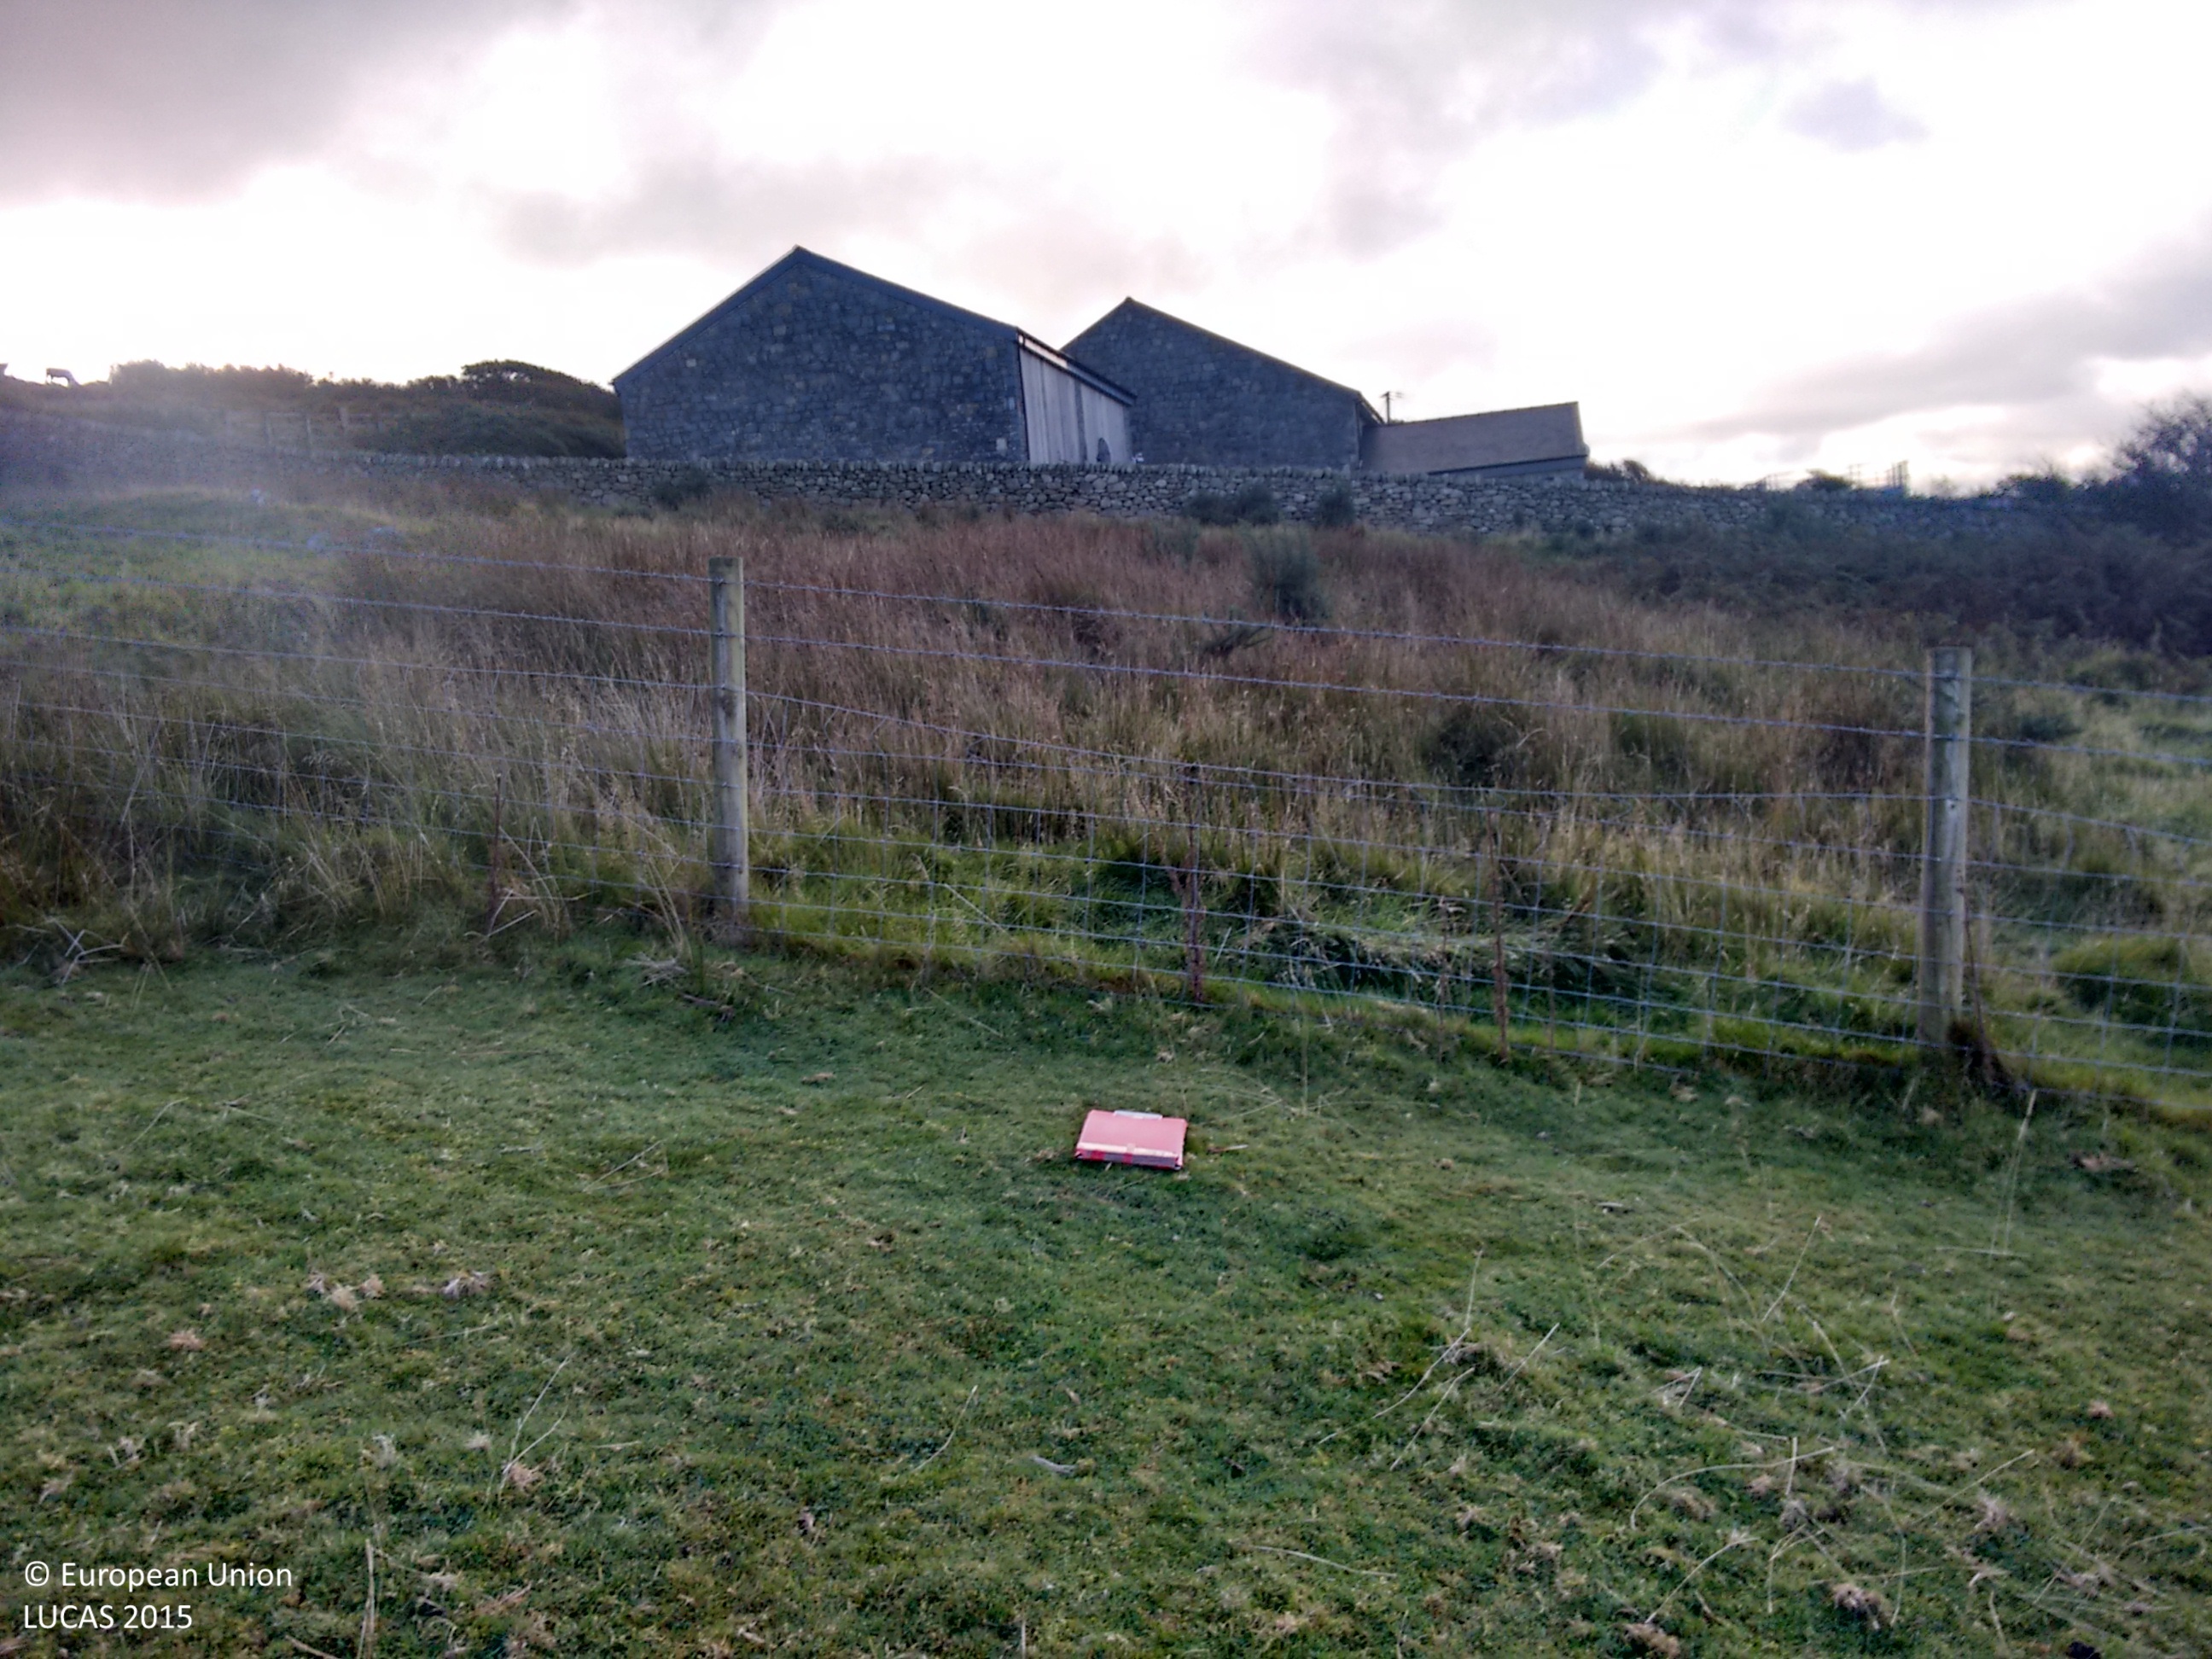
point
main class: Grassland
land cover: Grassland without tree/shrub cover
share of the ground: > 75 %
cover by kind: herbaceous plants 100 %
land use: Agriculture (excluding fallow land and kitchen gardens)
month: October
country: GB
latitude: 52.7752
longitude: -4.0747
